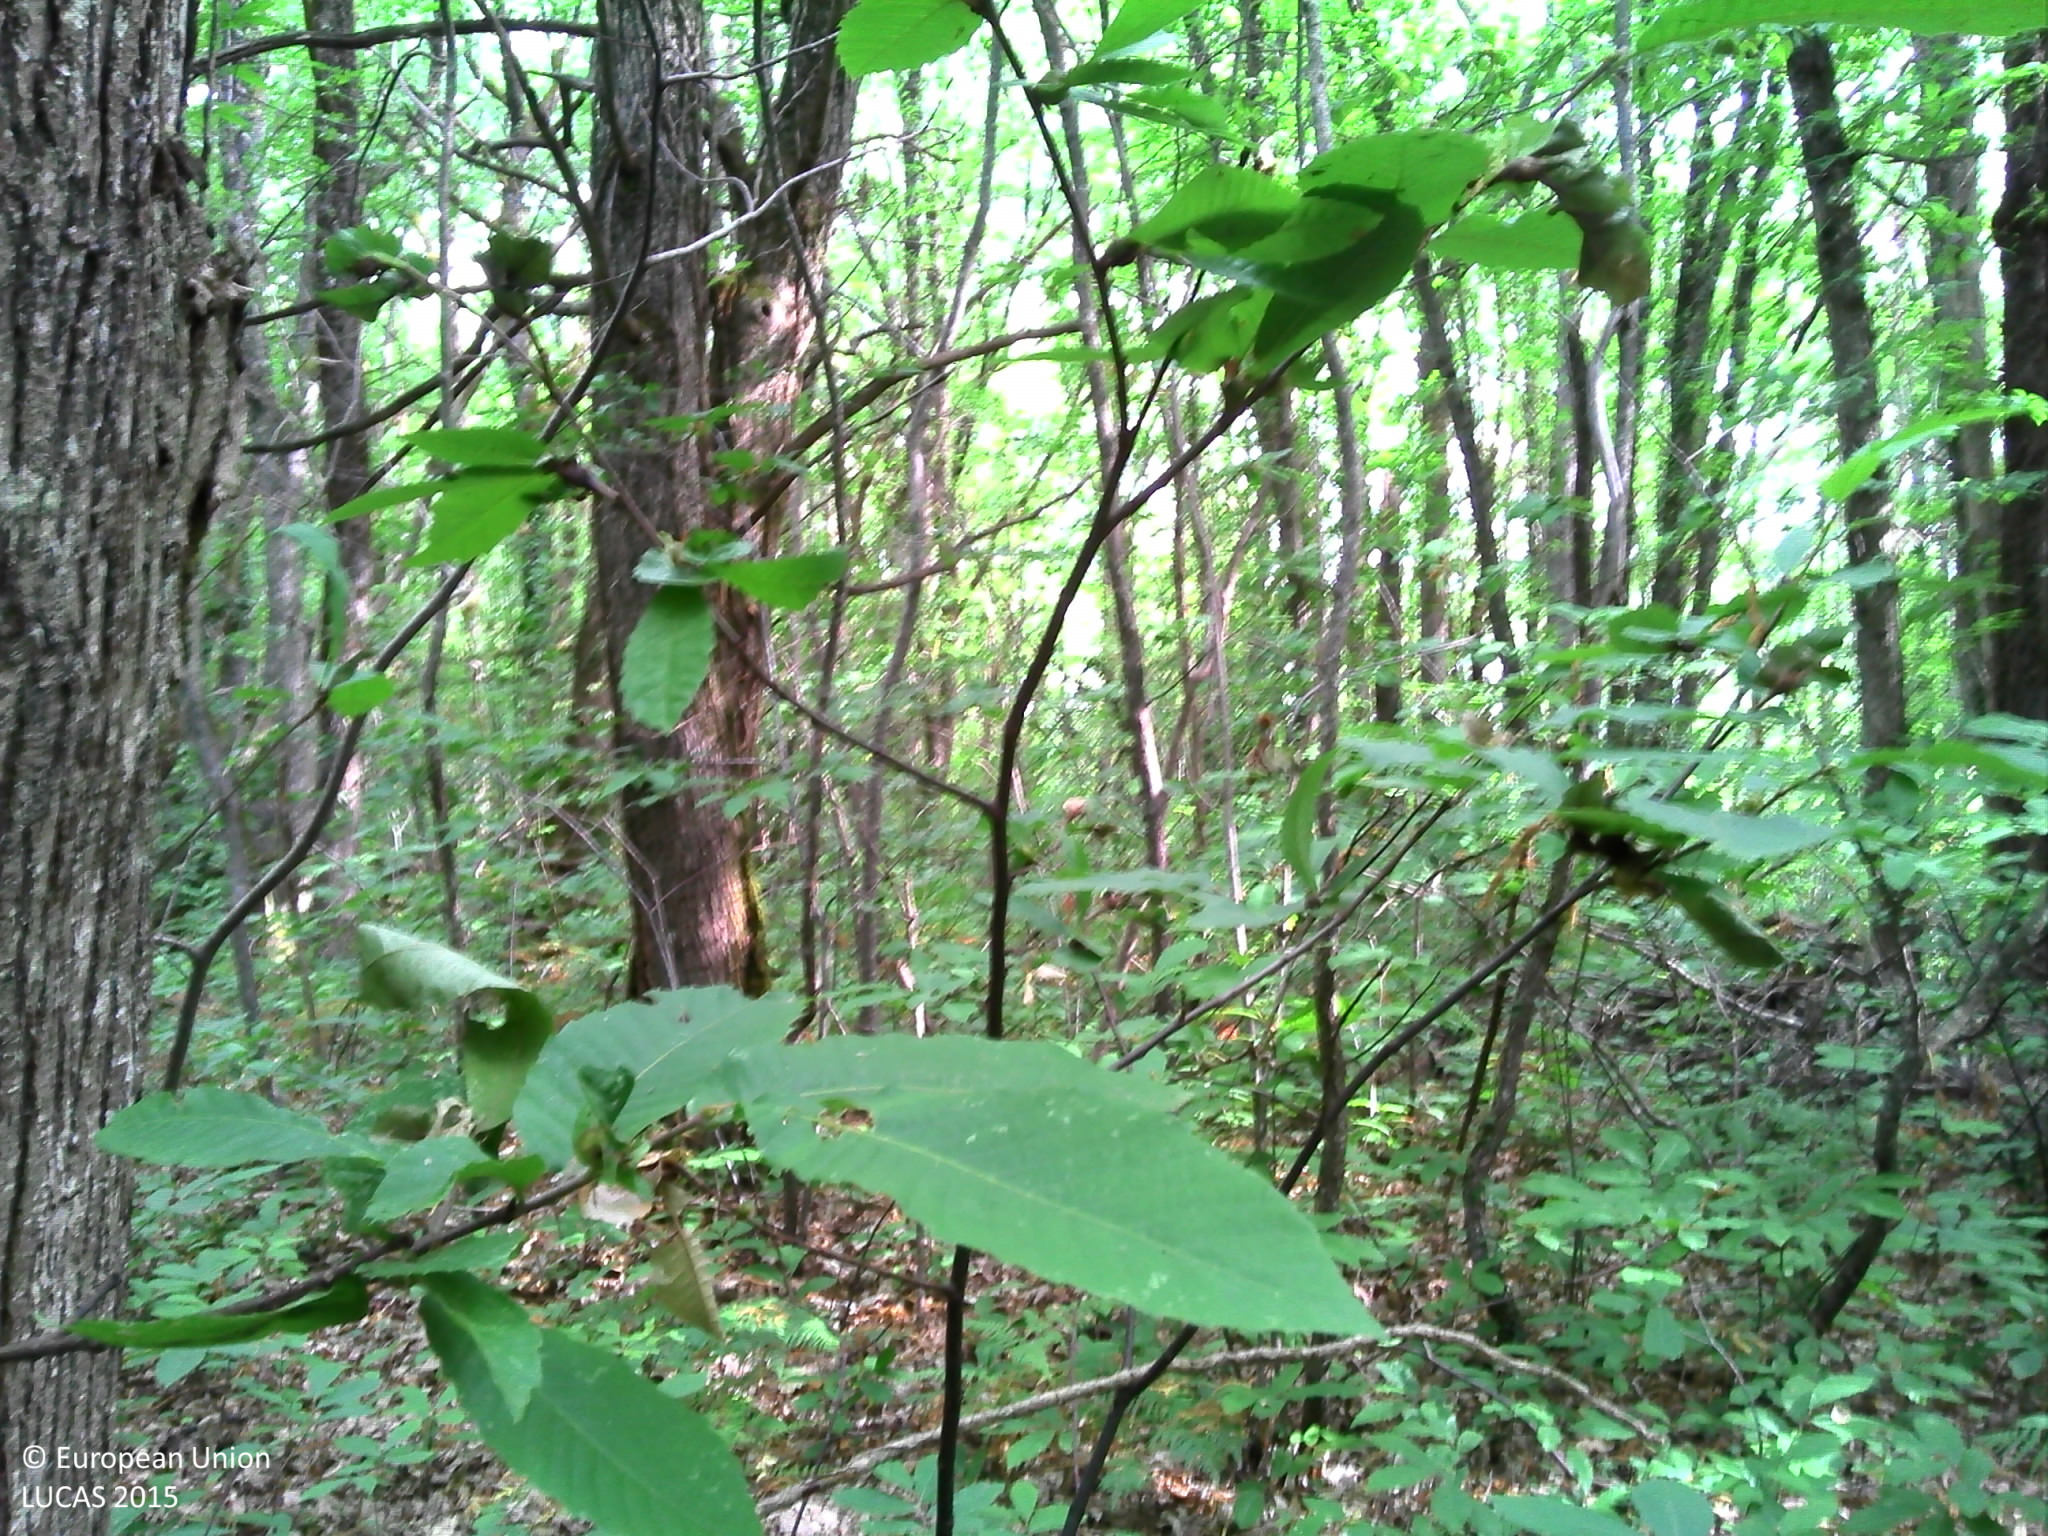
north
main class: Woodland
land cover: Broadleaved woodland
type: thermophilous deciduous forest
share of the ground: > 75 %
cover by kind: broadleaved forest trees 80 %, herbaceous plants 10 %, shrubs 5 %, lichens and mosses 5 %
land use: Forestry
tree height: > 5 m
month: July
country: FR
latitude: 44.9906
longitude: 0.7703
